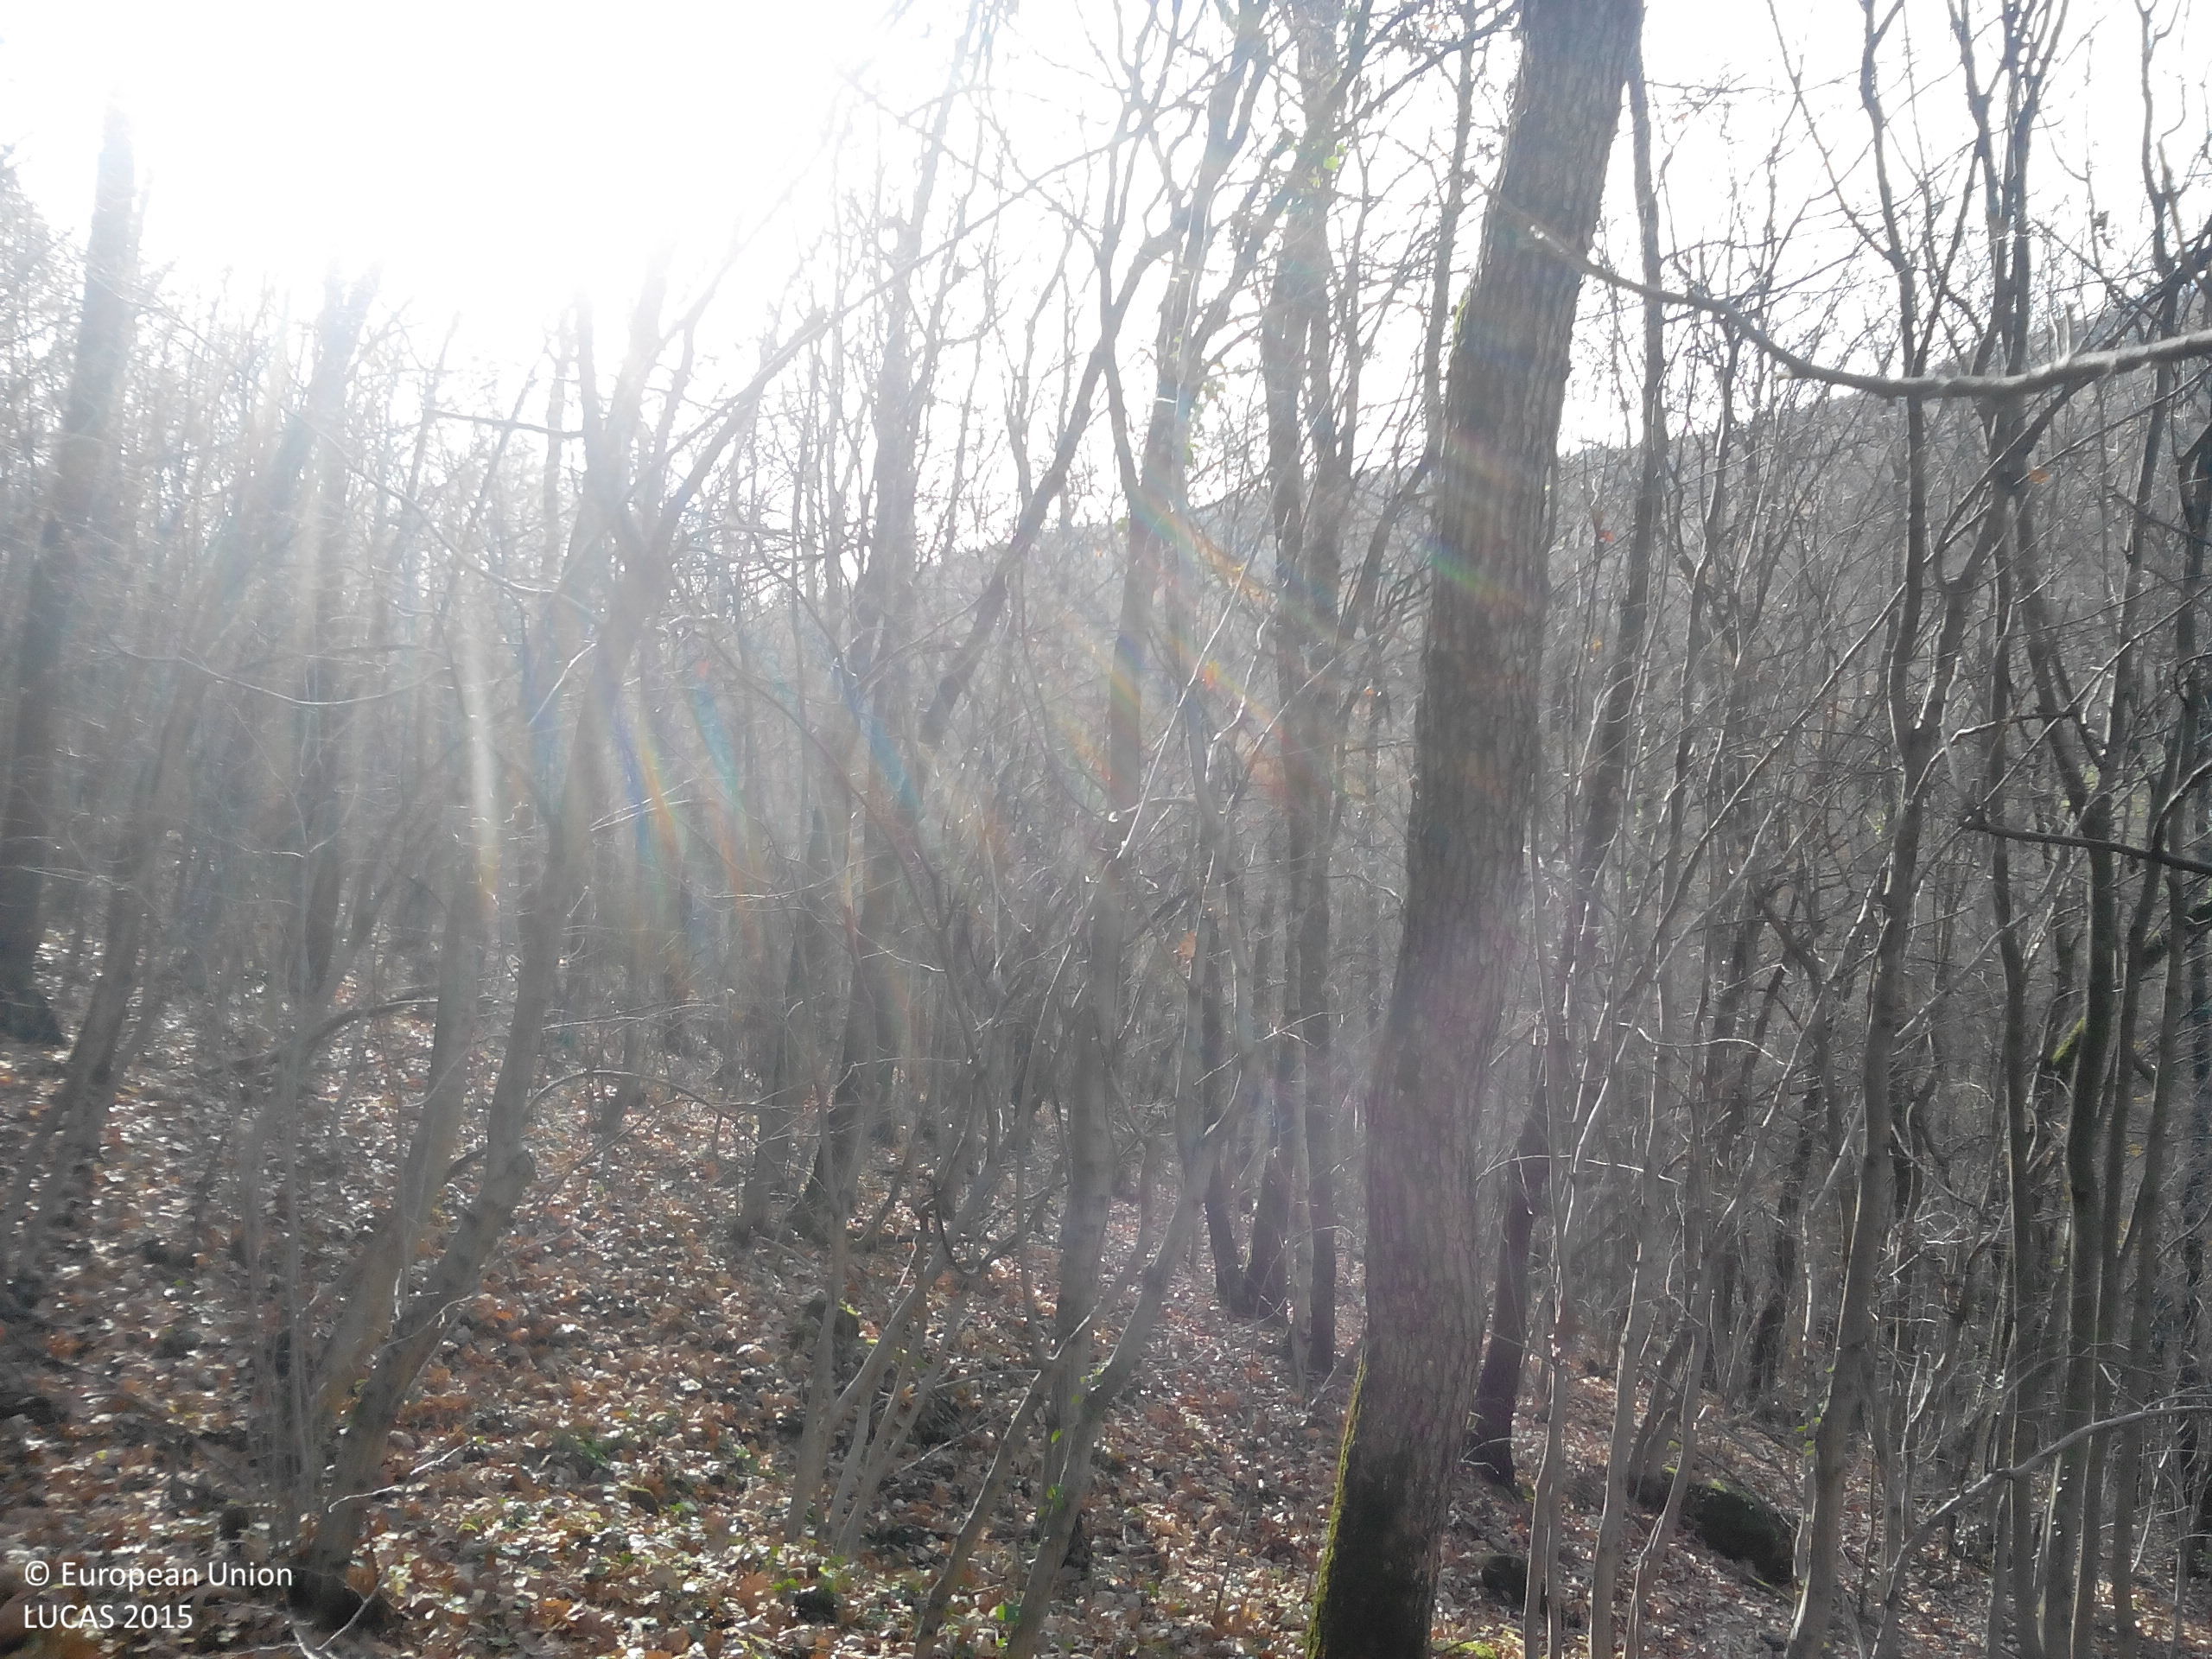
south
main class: Woodland
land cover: Broadleaved woodland
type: mesophytic deciduous forest
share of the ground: > 75 %
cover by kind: broadleaved forest trees 95 %, shrubs 5 %
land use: Forestry
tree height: > 5 m
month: November
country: BG
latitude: 43.1084
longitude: 23.6964
